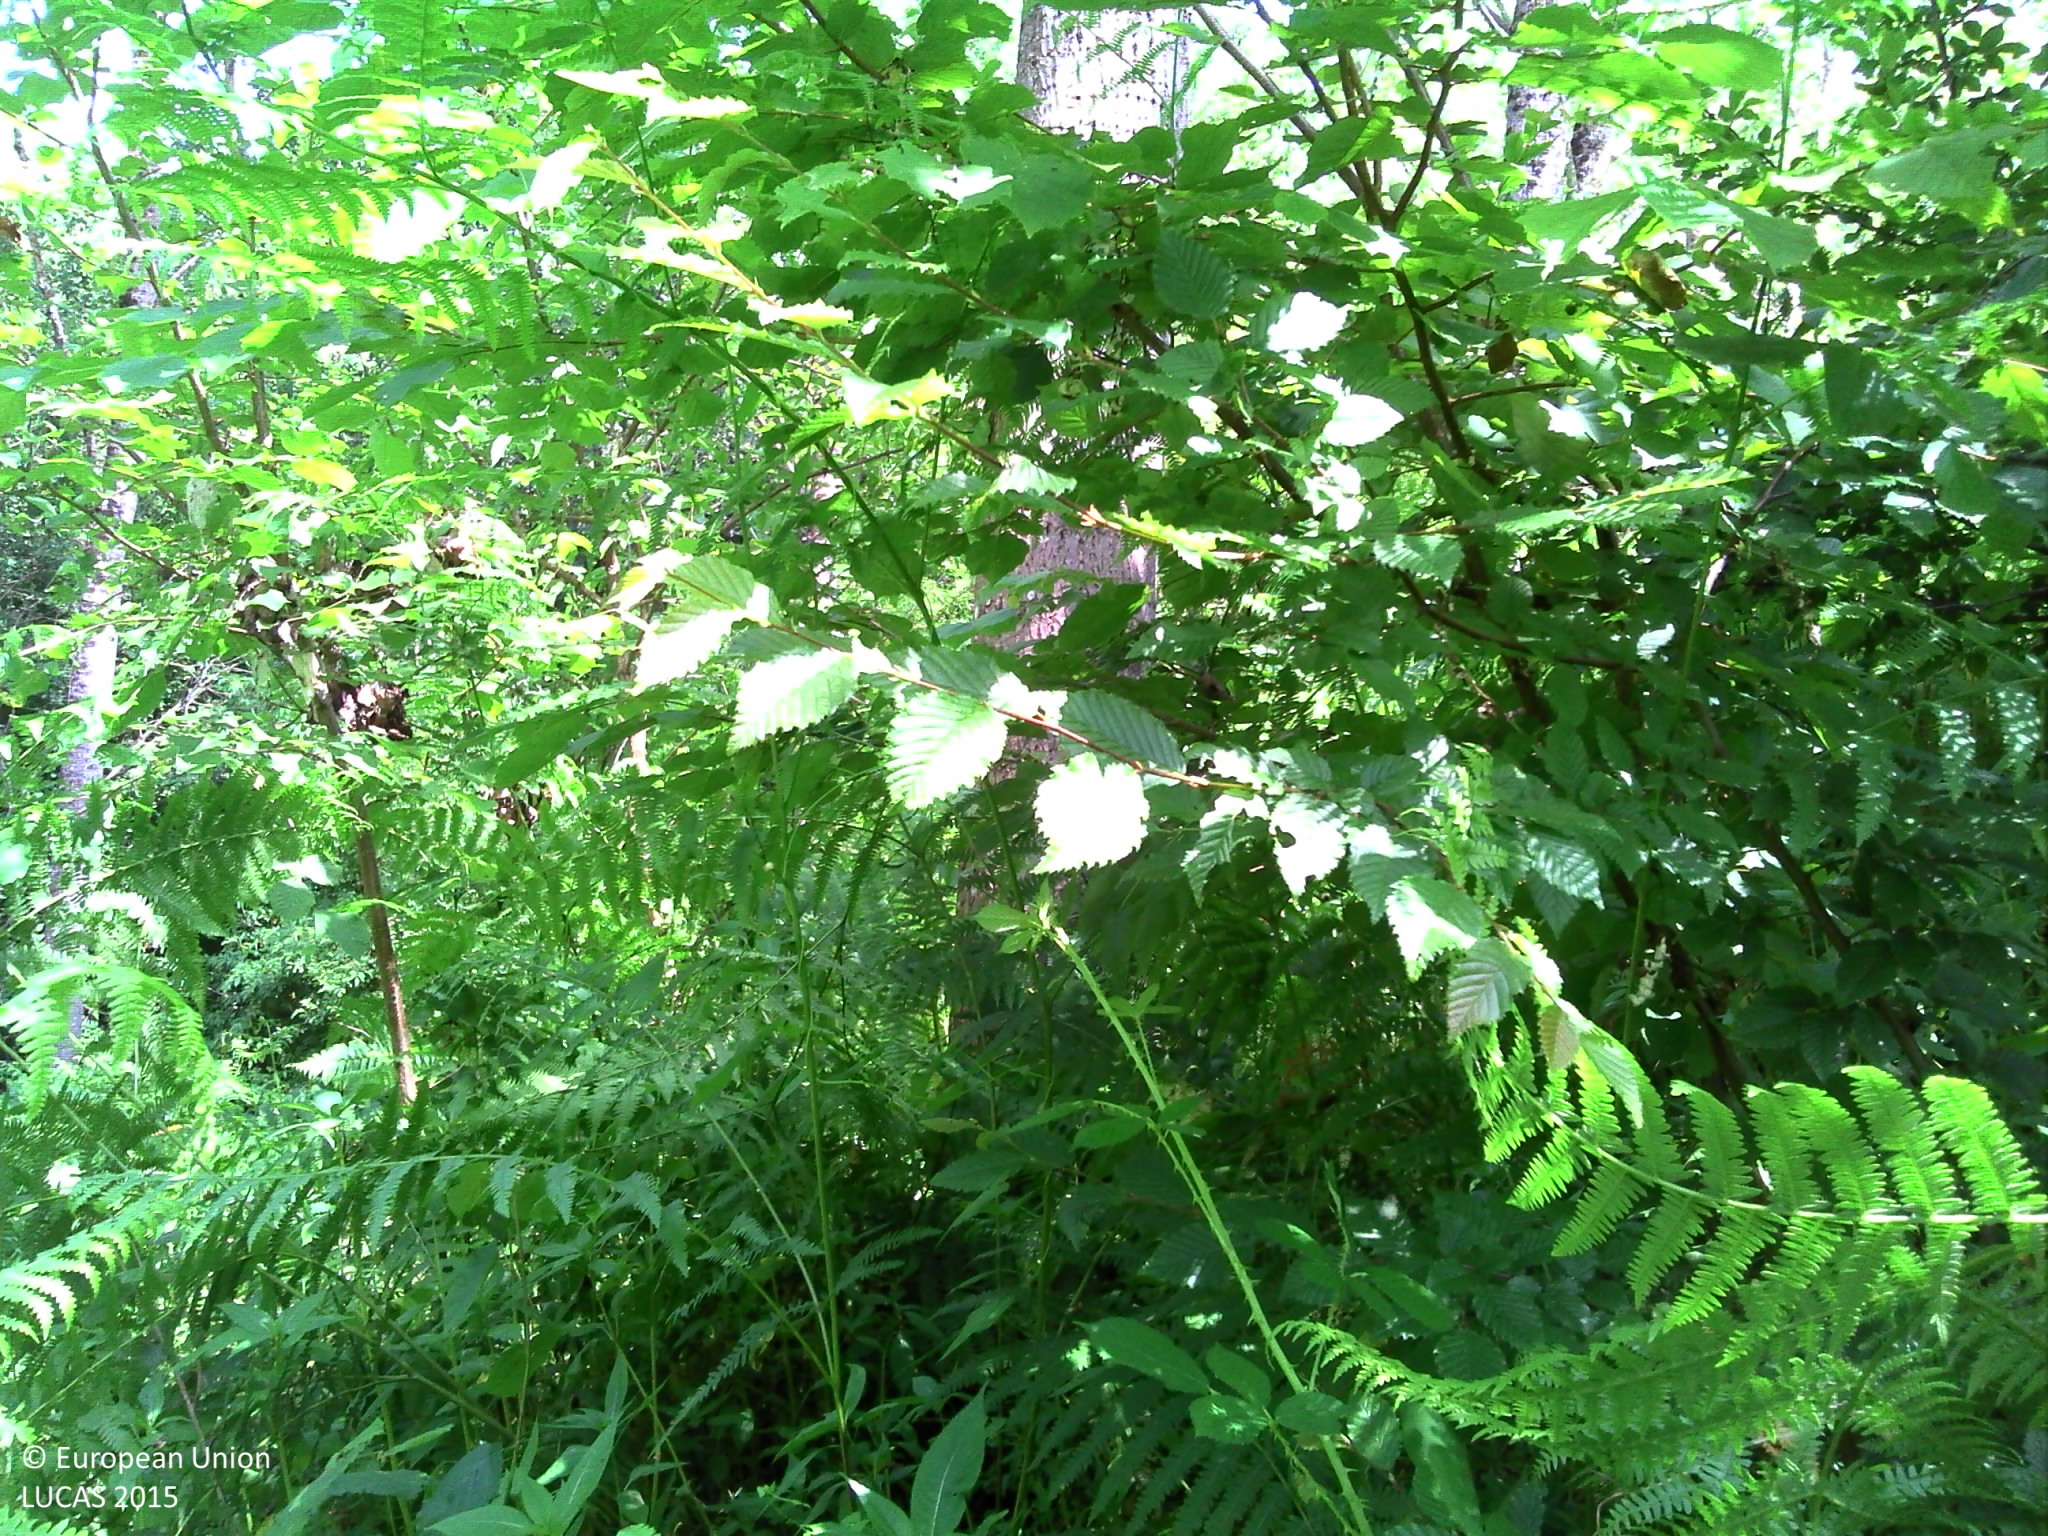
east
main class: Shrubland
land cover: Shrubland without tree cover
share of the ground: > 75 %
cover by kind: shrubs 40 %, herbaceous plants 30 %, lichens and mosses 30 %
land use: Semi-natural and natural areas not in use
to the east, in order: Shrubland without tree cover; Broadleaved woodland; Shrubland without tree cover; Broadleaved woodland; Rivers and streams; Broadleaved woodland; Grass margins; Tracks; Grass margins; Broadleaved woodland
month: July
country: FR
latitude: 43.0053
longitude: 0.8884
